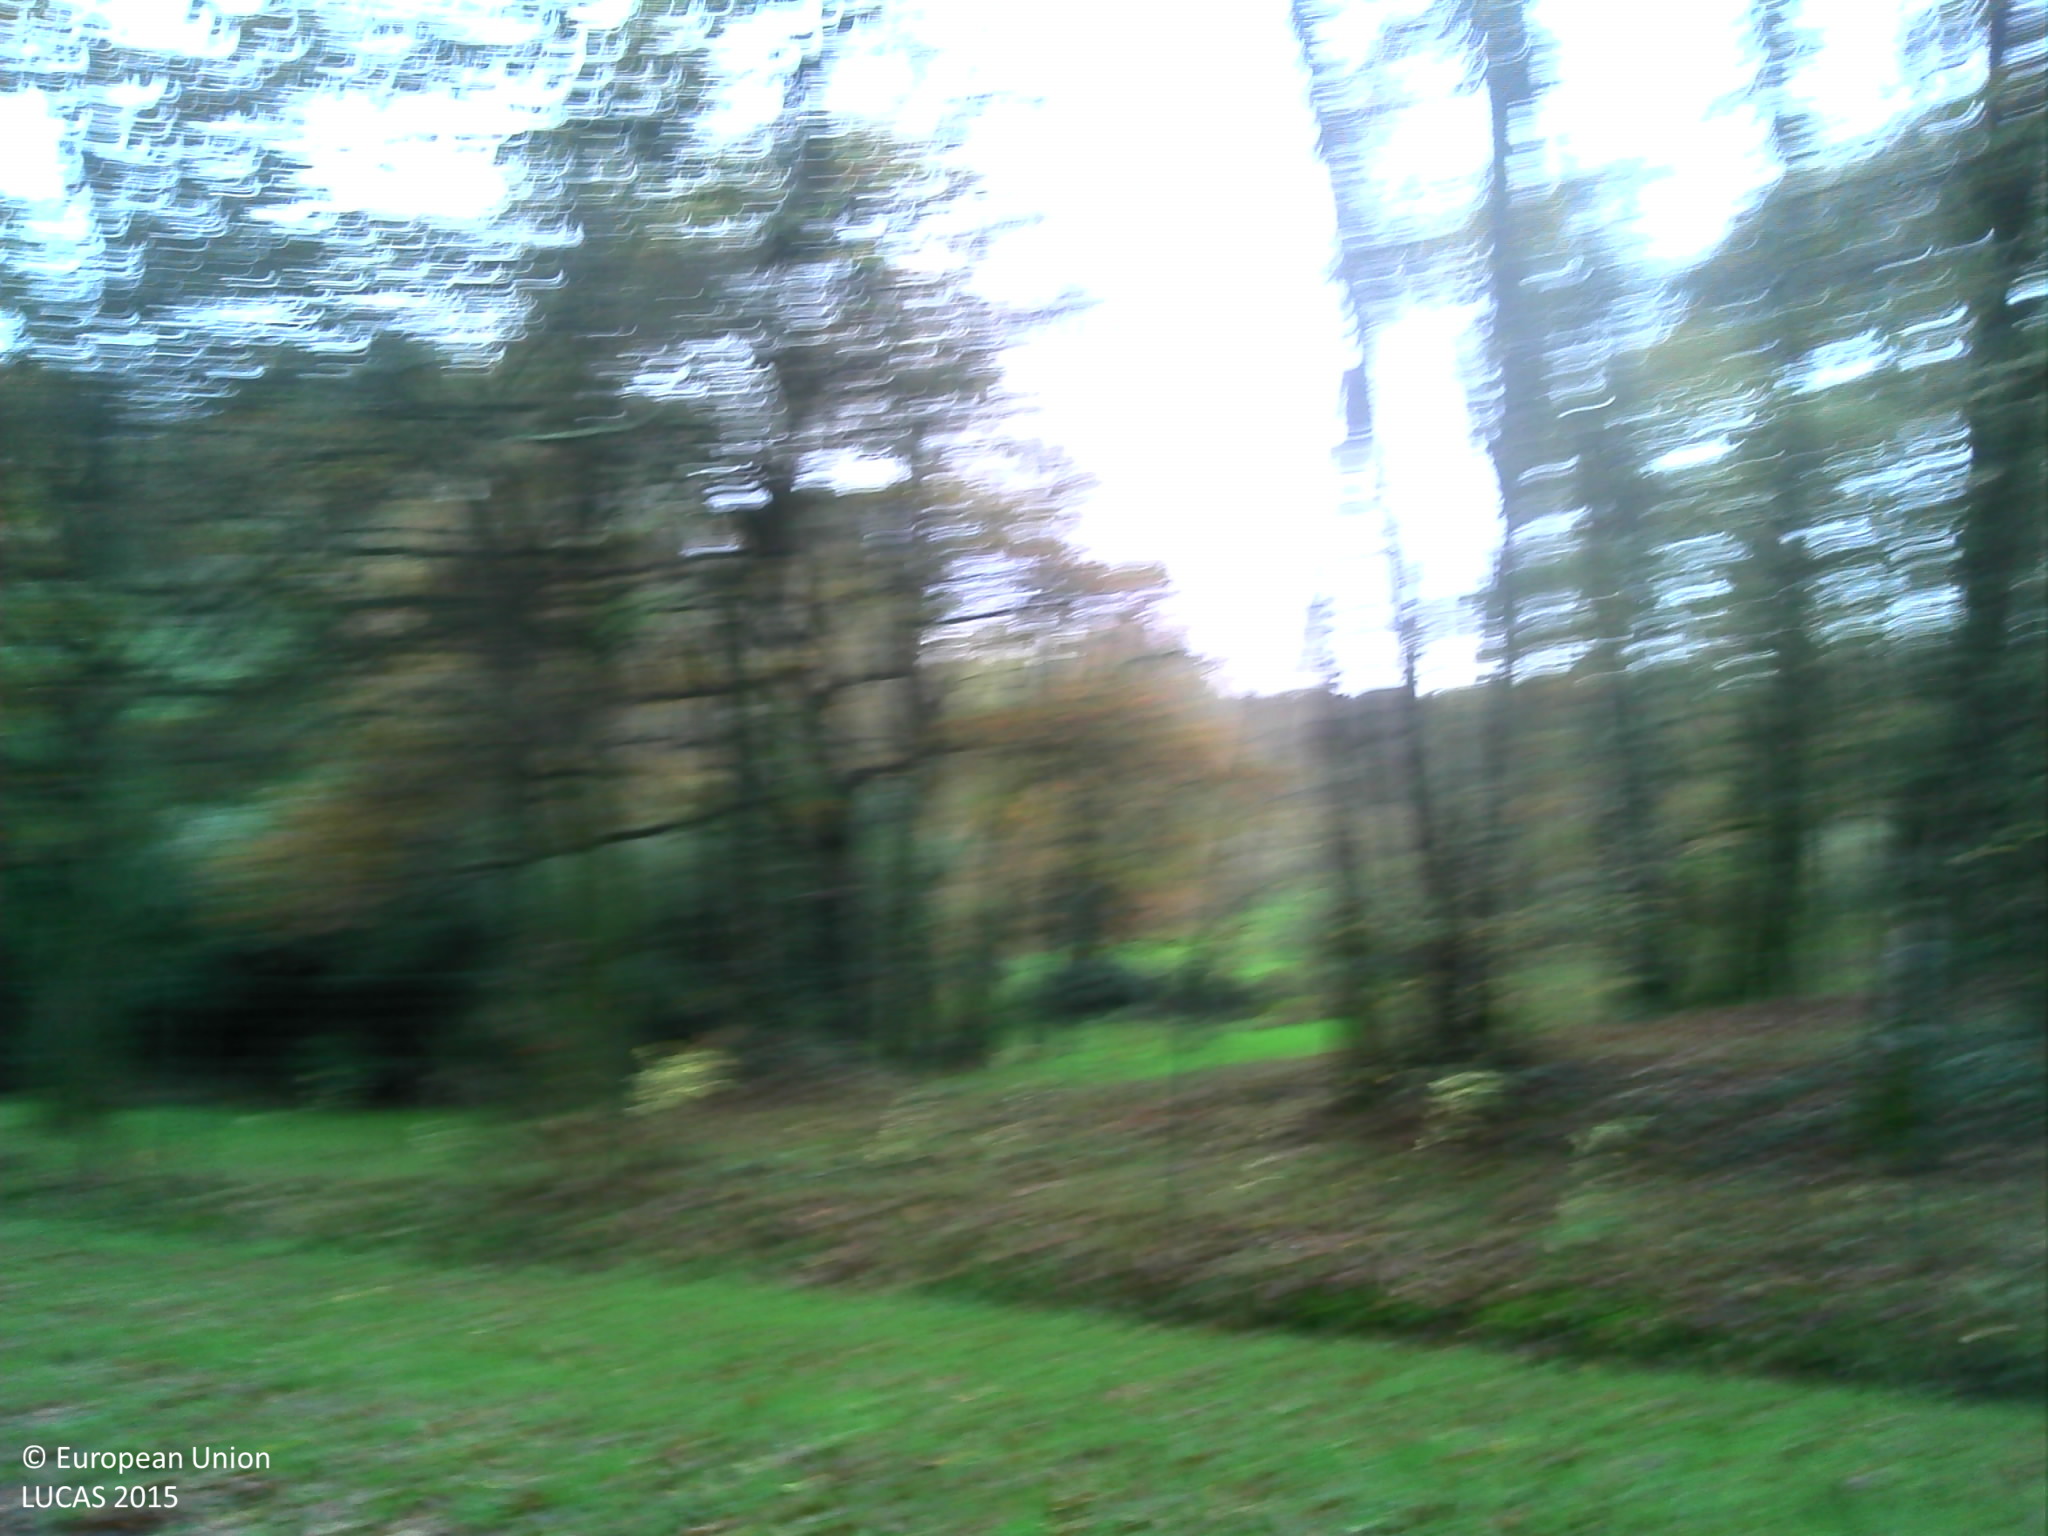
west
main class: Woodland
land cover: Broadleaved woodland
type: mesophytic deciduous forest
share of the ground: > 75 %
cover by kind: broadleaved forest trees 100 %
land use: Forestry
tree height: > 5 m
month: November
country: FR
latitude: 48.0032
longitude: -3.2476
